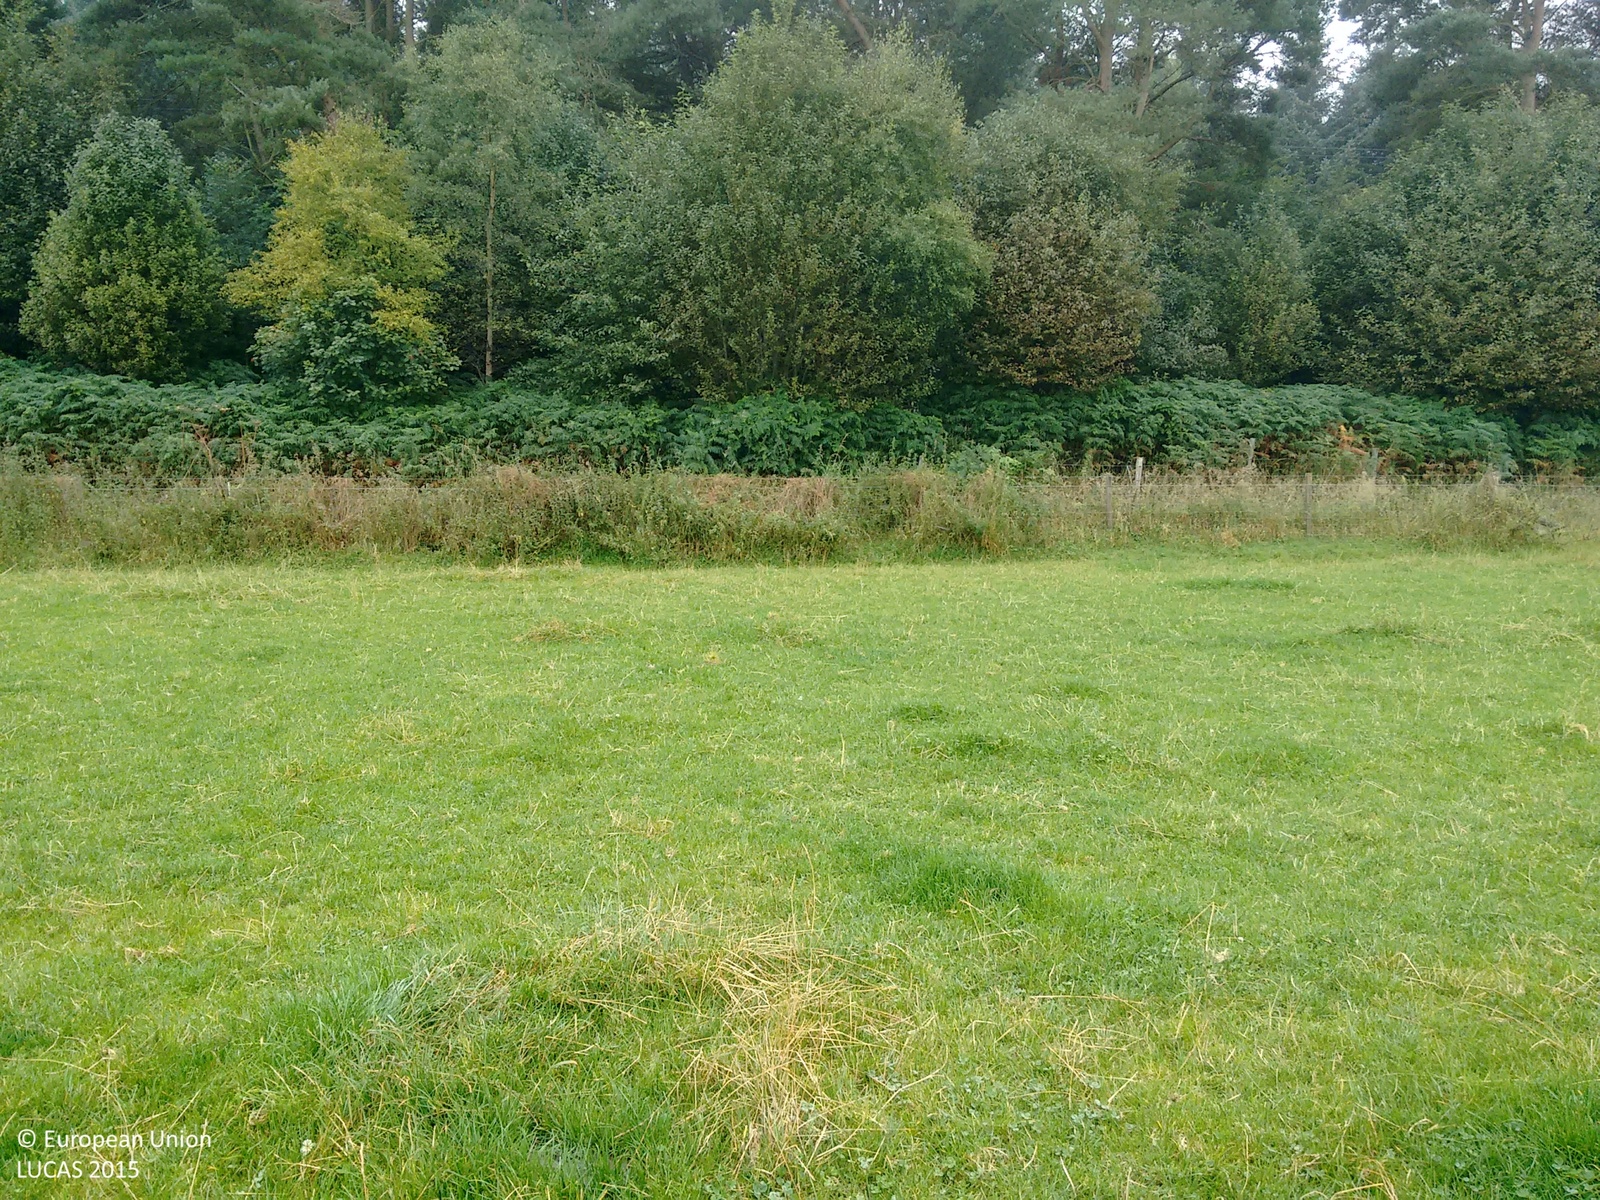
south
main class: Grassland
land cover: Grassland without tree/shrub cover
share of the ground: > 75 %
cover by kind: herbaceous plants 100 %
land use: Agriculture (excluding fallow land and kitchen gardens)
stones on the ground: < 10 %
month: September
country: GB
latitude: 57.5686
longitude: -3.8701
